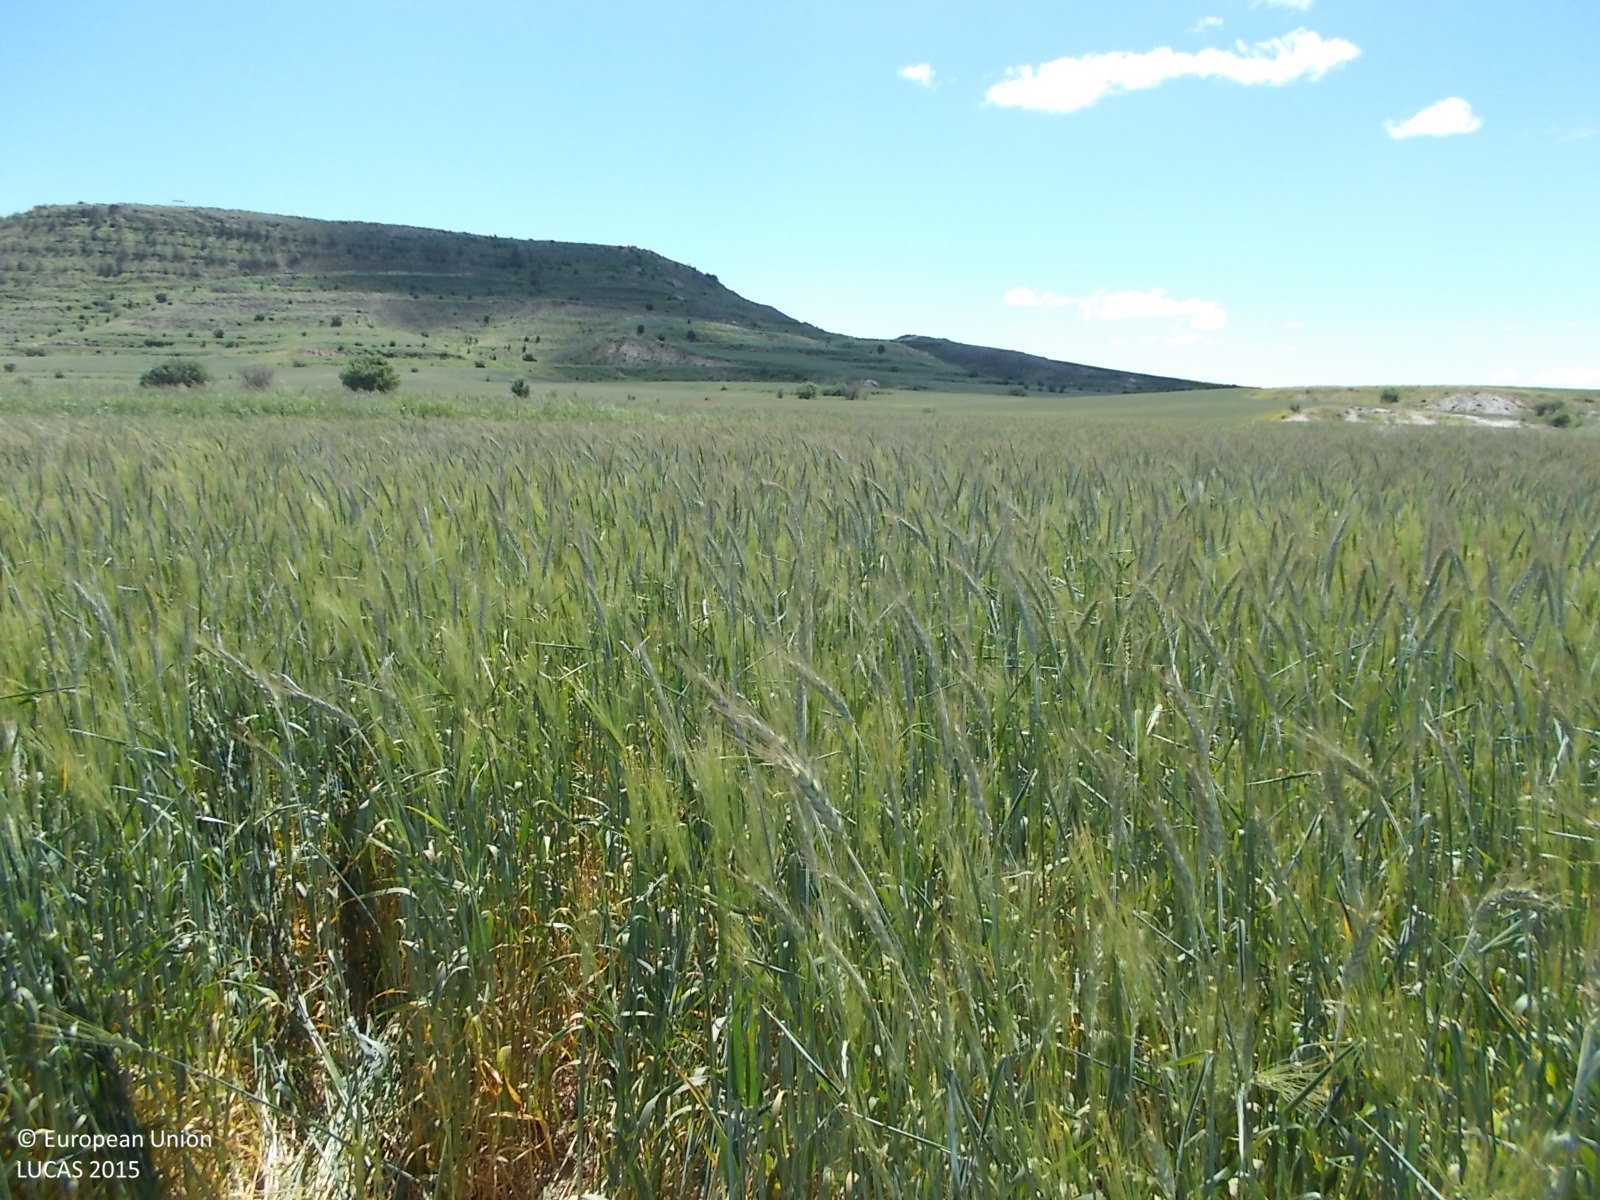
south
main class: Cropland
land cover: Mixed cereals for fodder
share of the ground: > 75 %
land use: Agriculture (excluding fallow land and kitchen gardens)
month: April
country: CY
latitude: 35.0199
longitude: 33.5055
